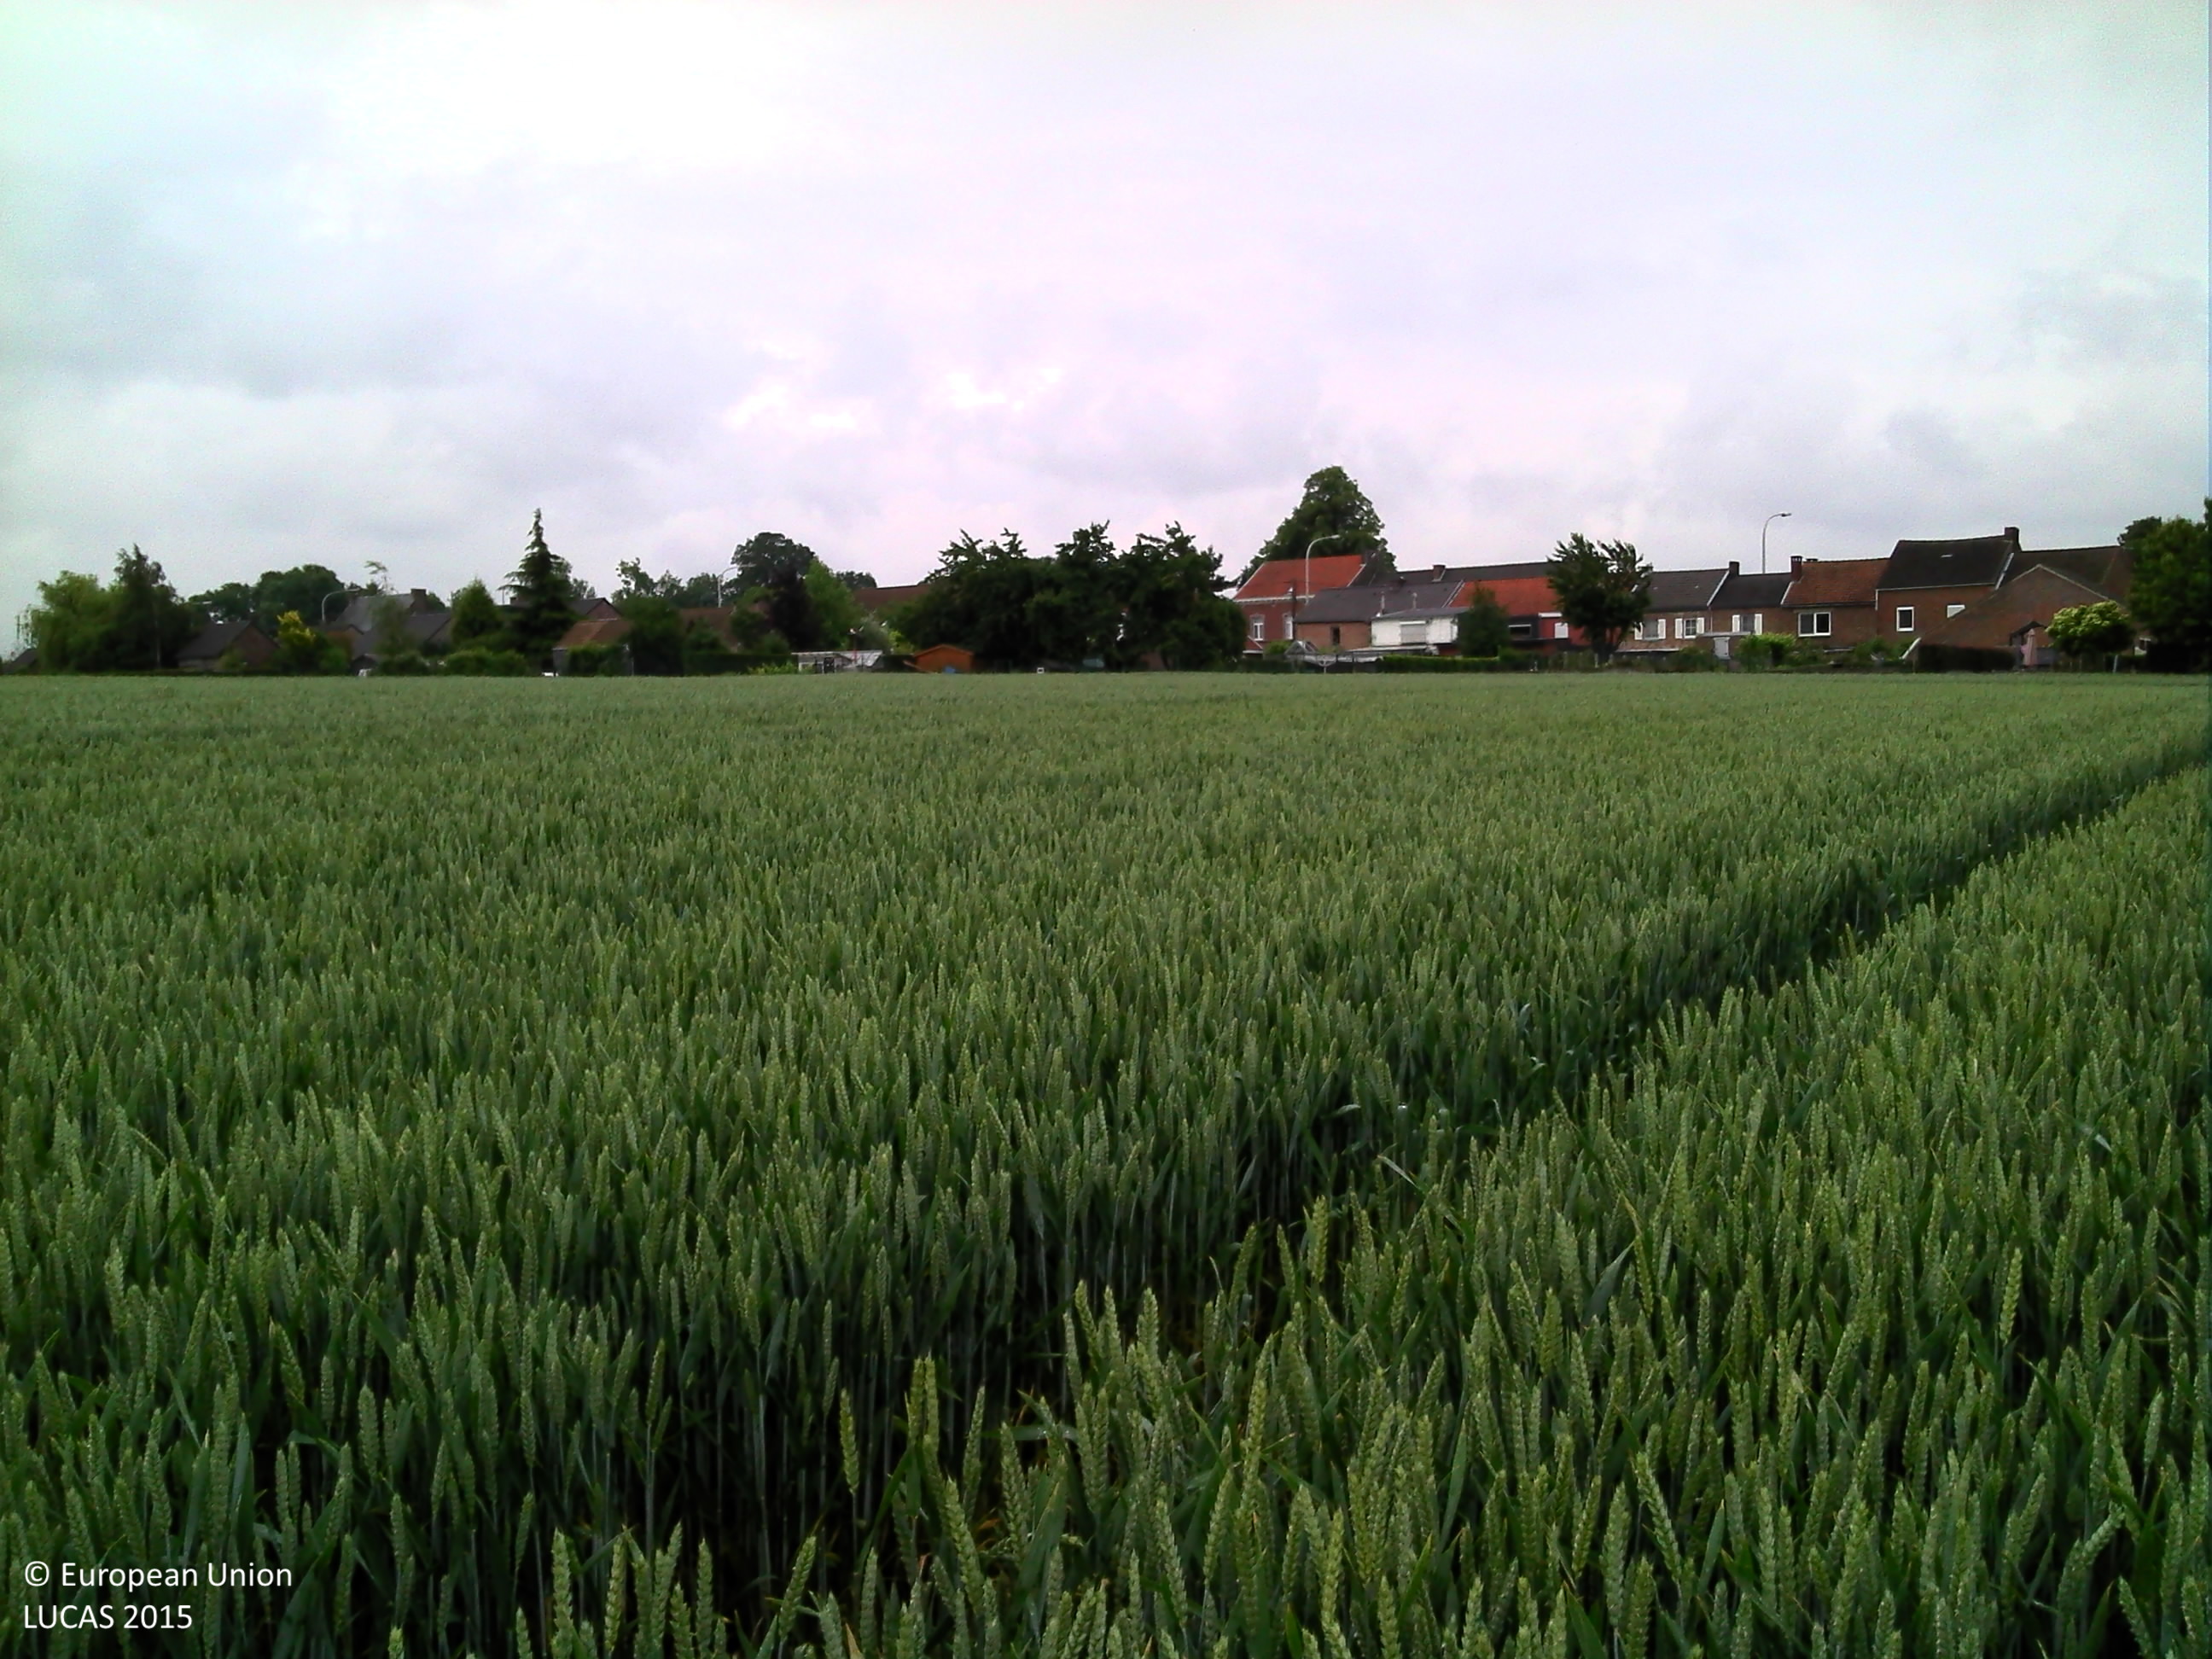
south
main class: Cropland
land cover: Common wheat
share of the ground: > 75 %
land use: Agriculture (excluding fallow land and kitchen gardens)
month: June
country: BE
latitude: 50.6880
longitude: 5.4544
